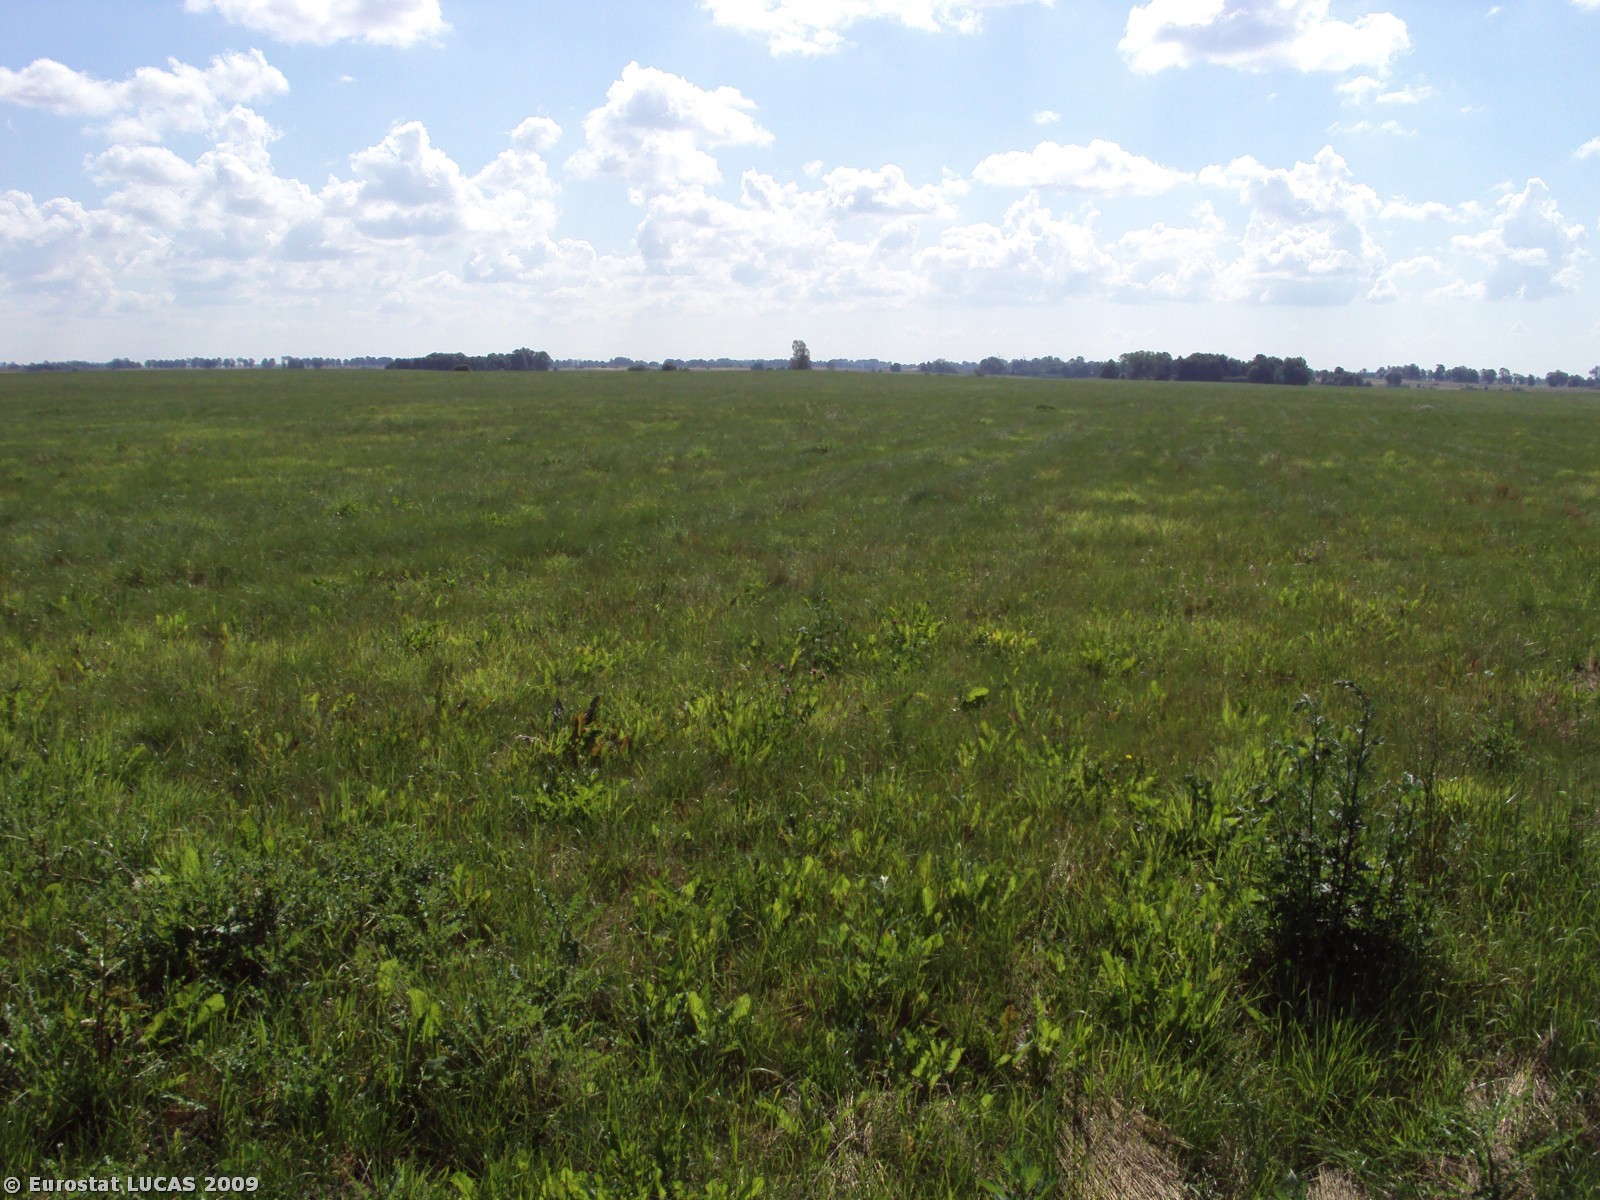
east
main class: Grassland
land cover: Grassland without tree/shrub cover
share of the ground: > 75 %
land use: Agriculture (excluding fallow land and kitchen gardens)
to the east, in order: Grassland without tree/shrub cover
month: August
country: PL
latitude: 53.2504
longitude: 16.4063
